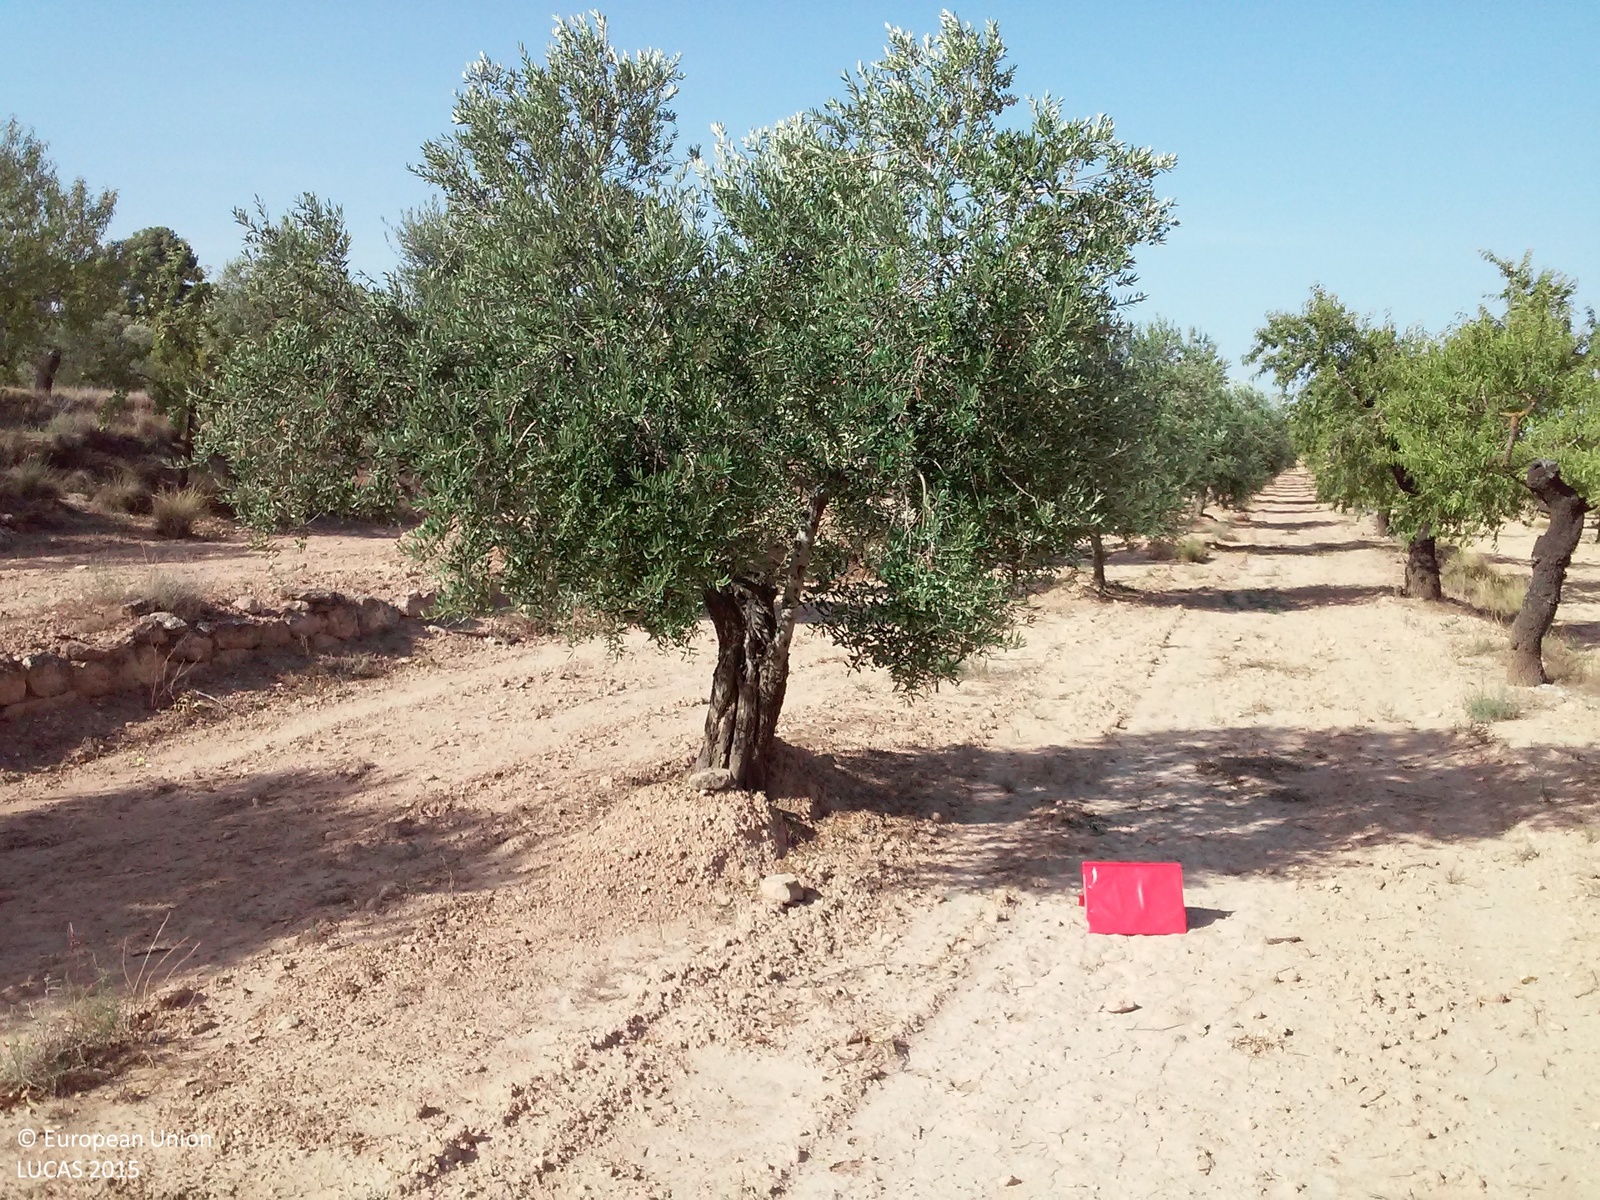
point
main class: Cropland
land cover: Olive groves
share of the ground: 10 - 25 %
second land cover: Nuts trees
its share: 10 - 25 %
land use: Agriculture (excluding fallow land and kitchen gardens)
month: August
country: ES
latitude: 41.3779
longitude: 0.5792
